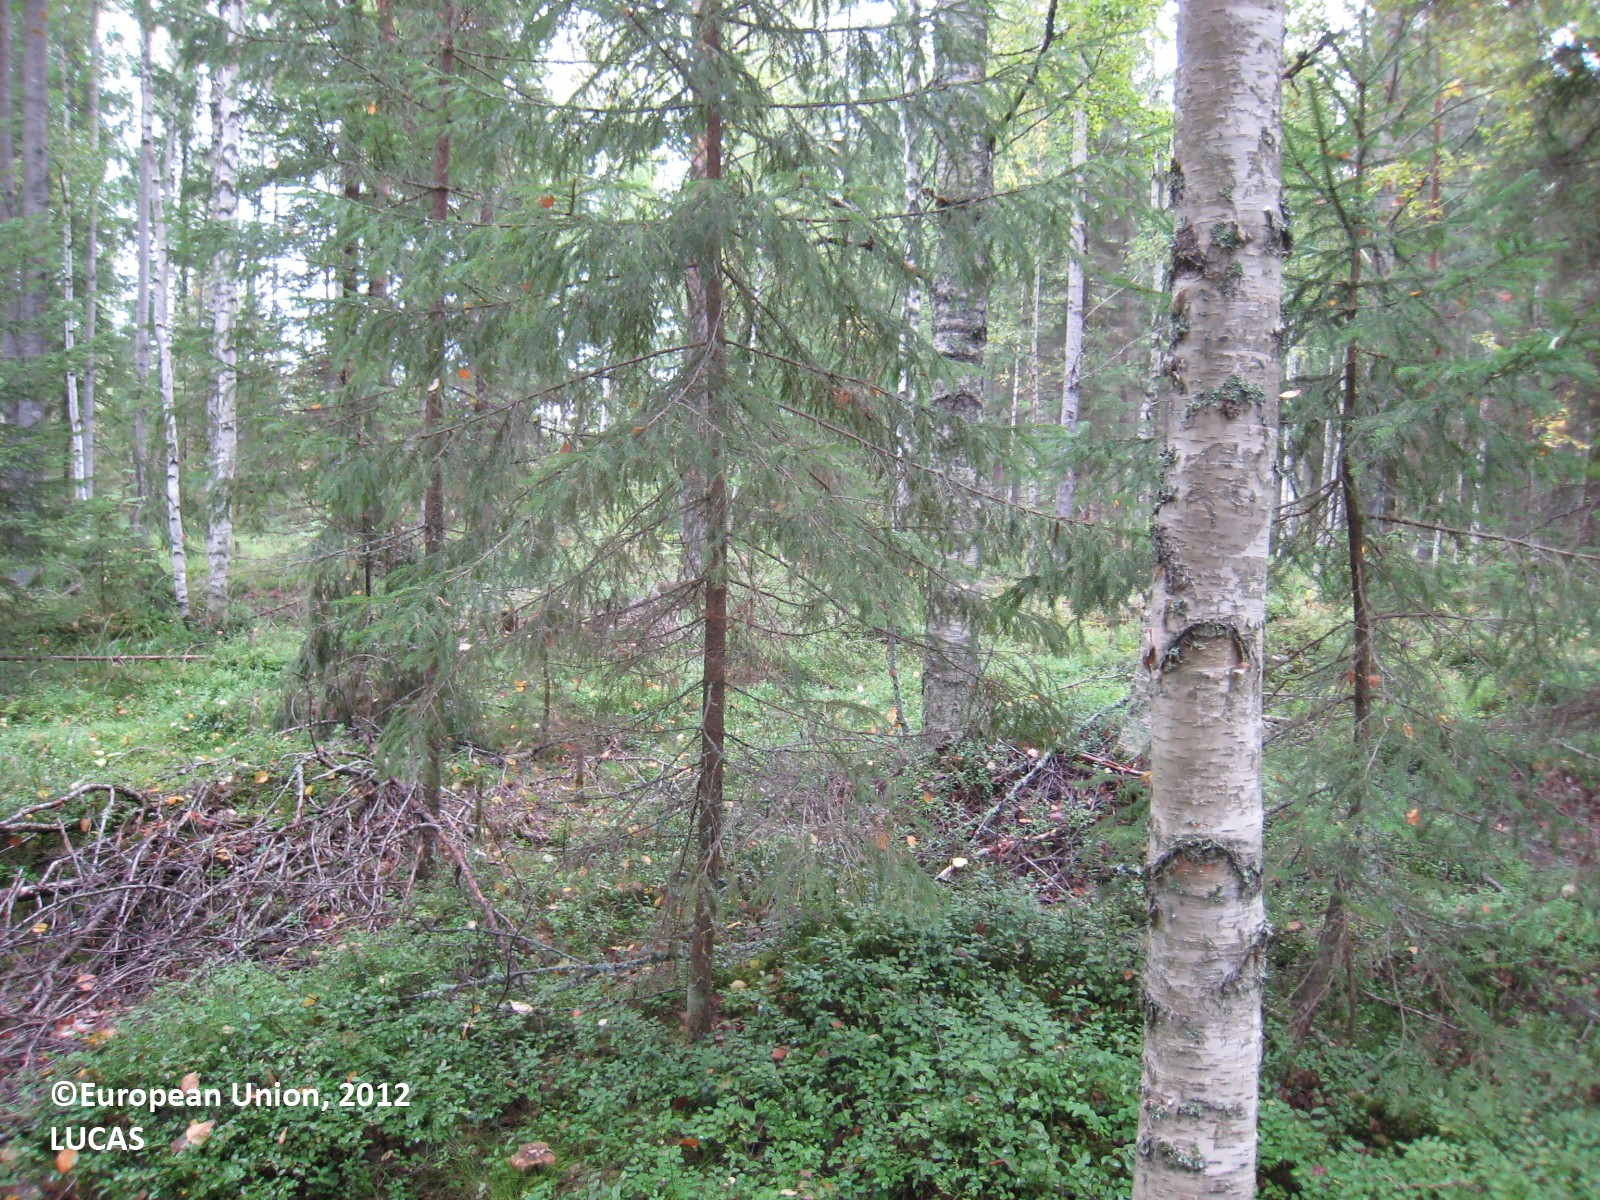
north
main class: Woodland
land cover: Spruce dominated mixed woodland
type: boreal forest
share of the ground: > 75 %
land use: Forestry
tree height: > 5 m
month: August
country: FI
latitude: 62.0546
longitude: 27.2059
